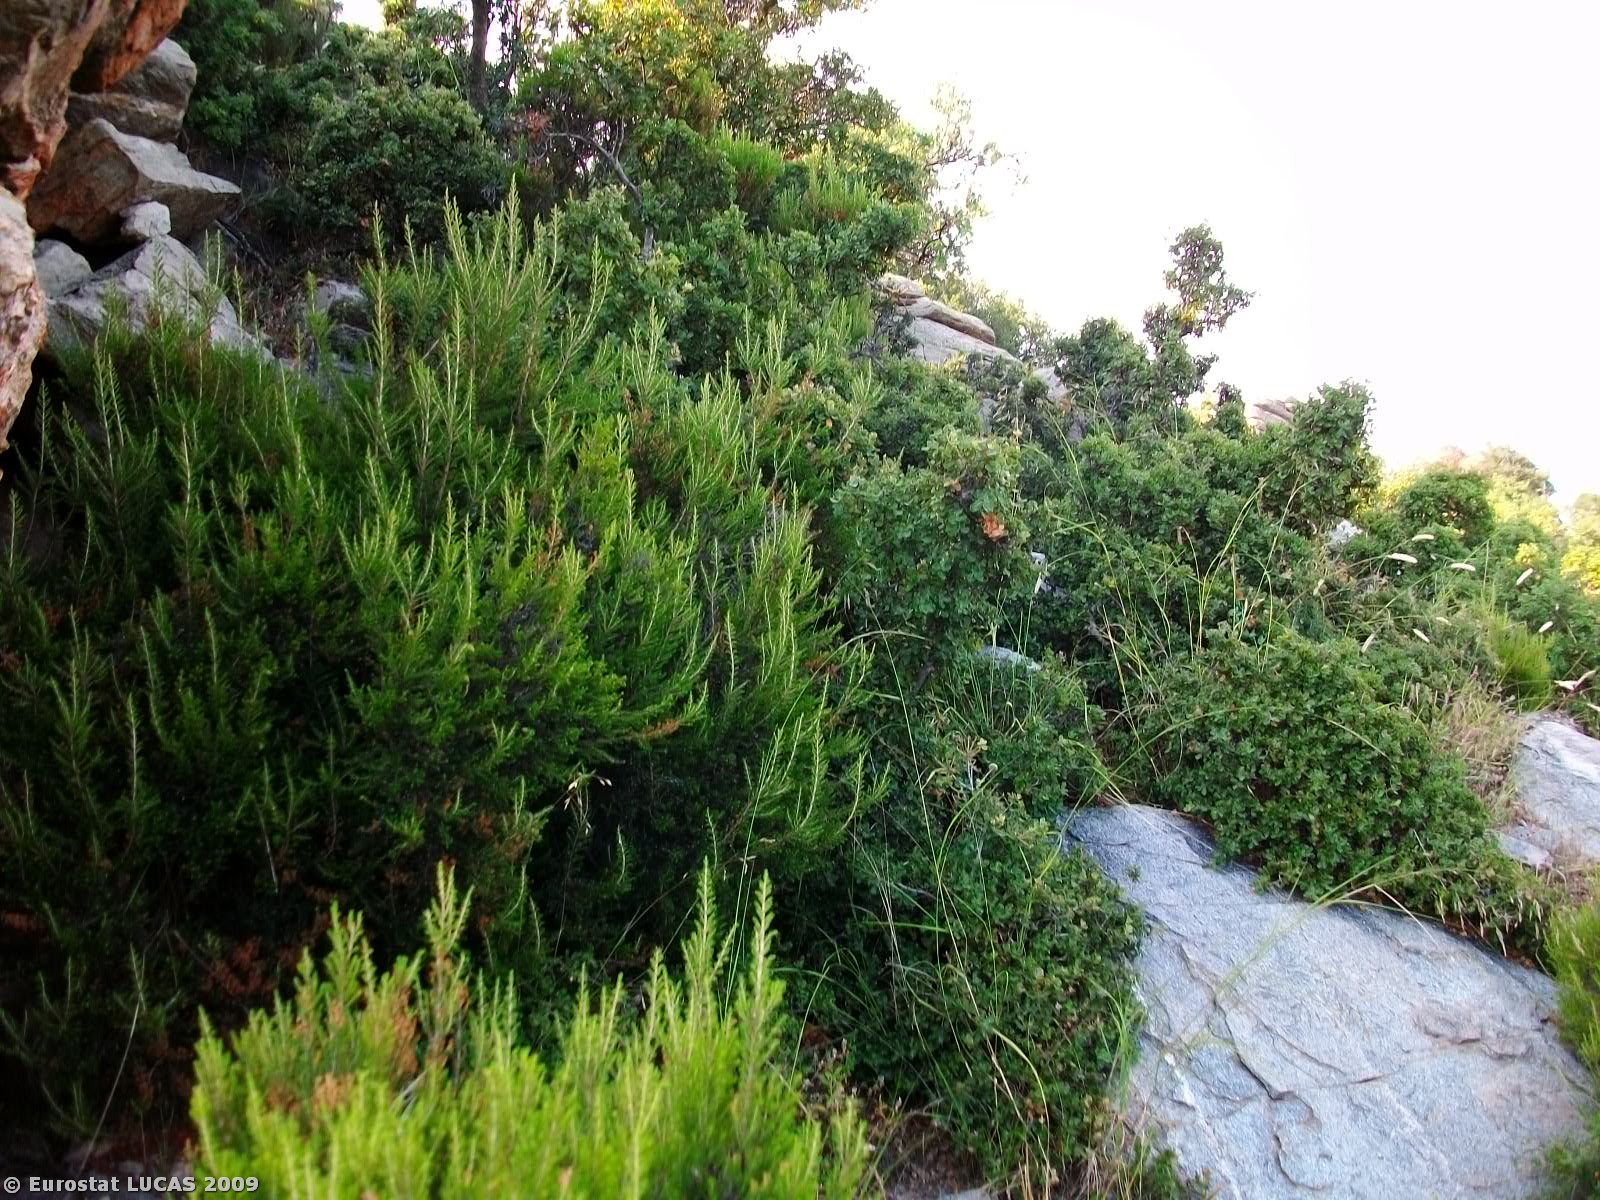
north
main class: Shrubland
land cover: Shrubland without tree cover
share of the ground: 50 - 75 %
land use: Agriculture (excluding fallow land and kitchen gardens)
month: June
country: GR
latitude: 40.8495
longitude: 24.2734
